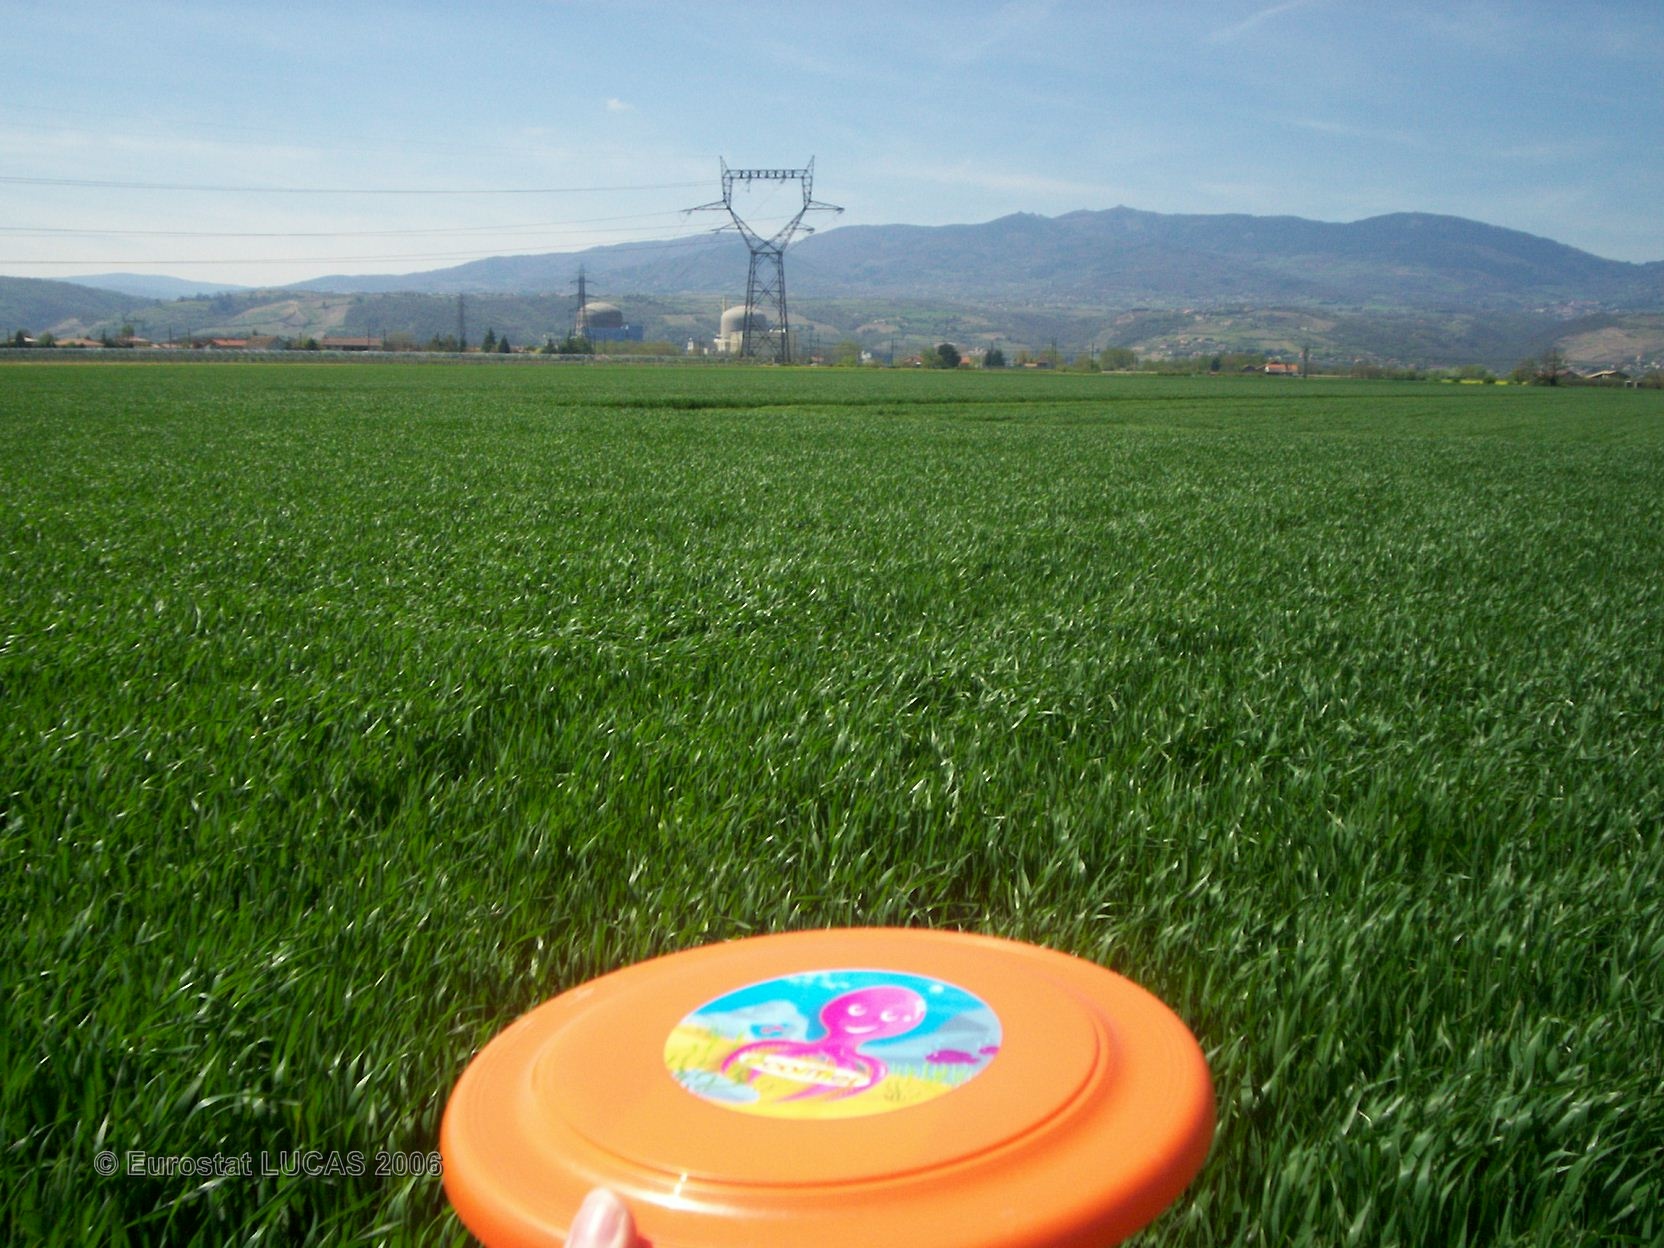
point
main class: Cropland
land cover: Triticale
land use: Agriculture (excluding fallow land and kitchen gardens)
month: April
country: FR
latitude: 45.4113
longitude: 4.7783
